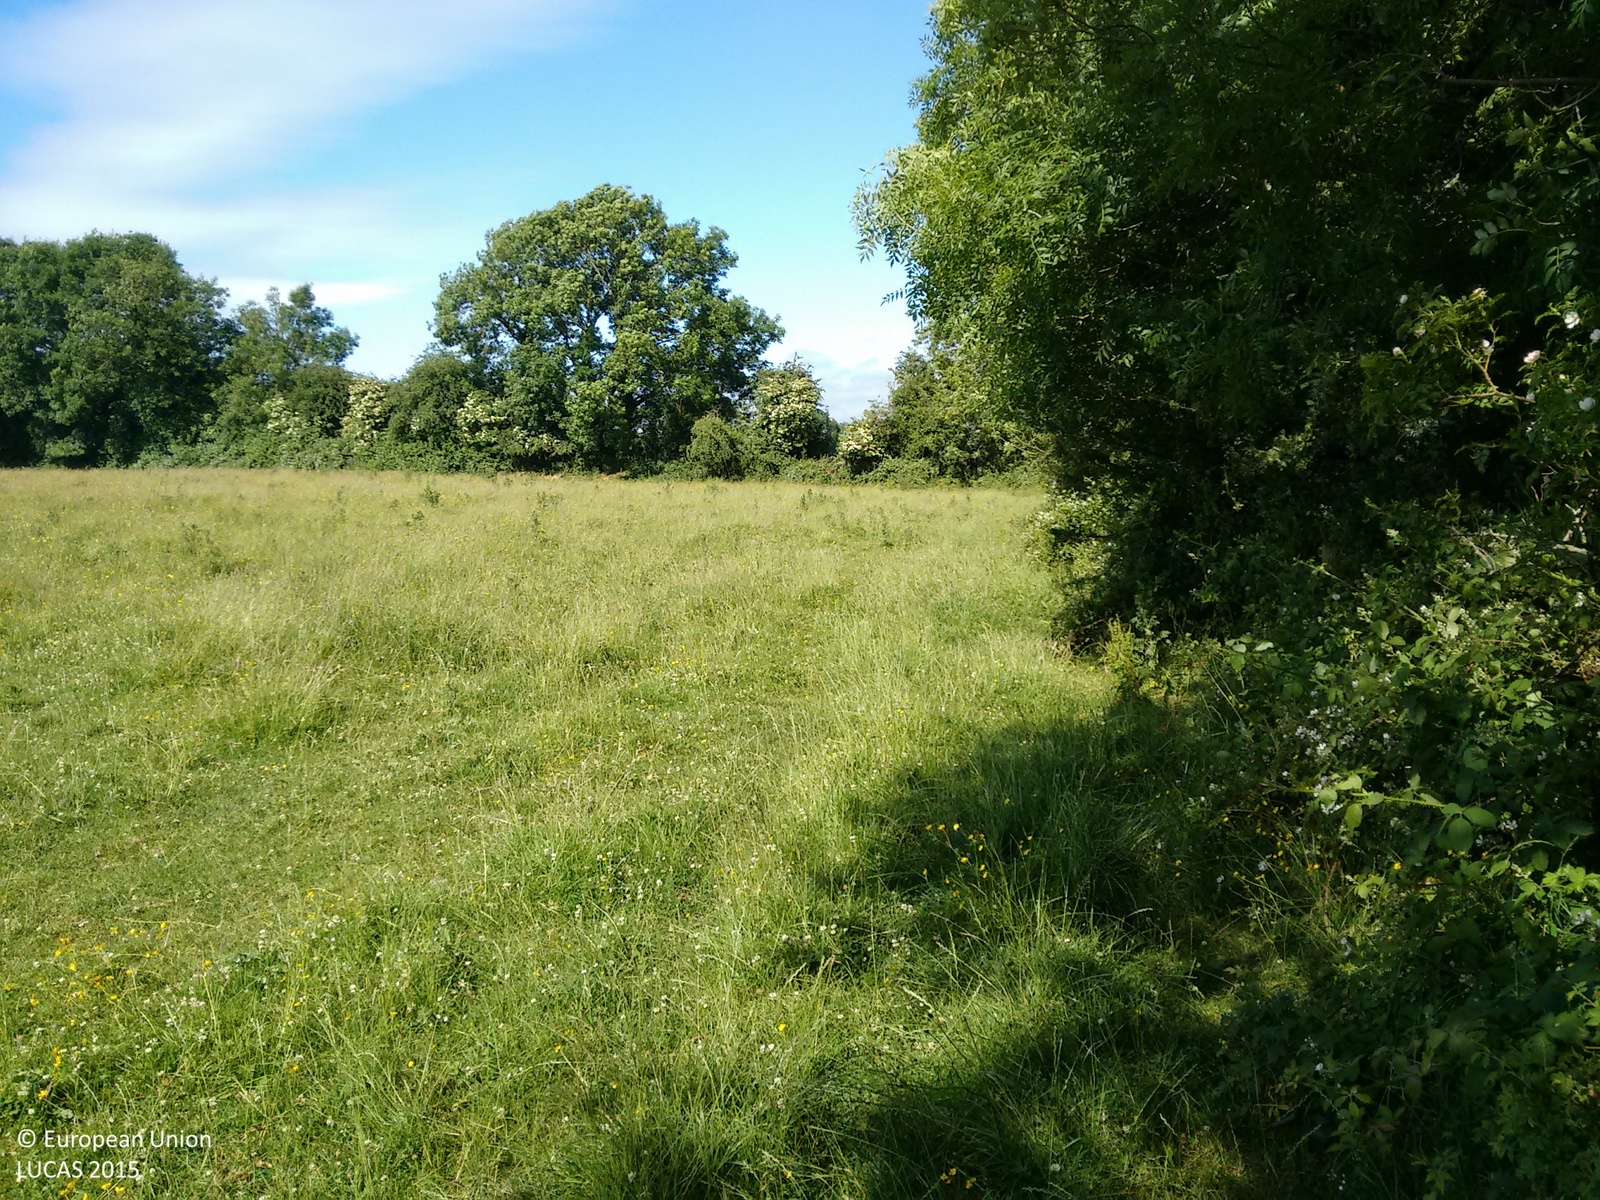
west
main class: Grassland
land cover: Grassland without tree/shrub cover
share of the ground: > 75 %
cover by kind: herbaceous plants 100 %
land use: Agriculture (excluding fallow land and kitchen gardens)
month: June
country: IE
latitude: 53.6639
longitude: -6.7041
